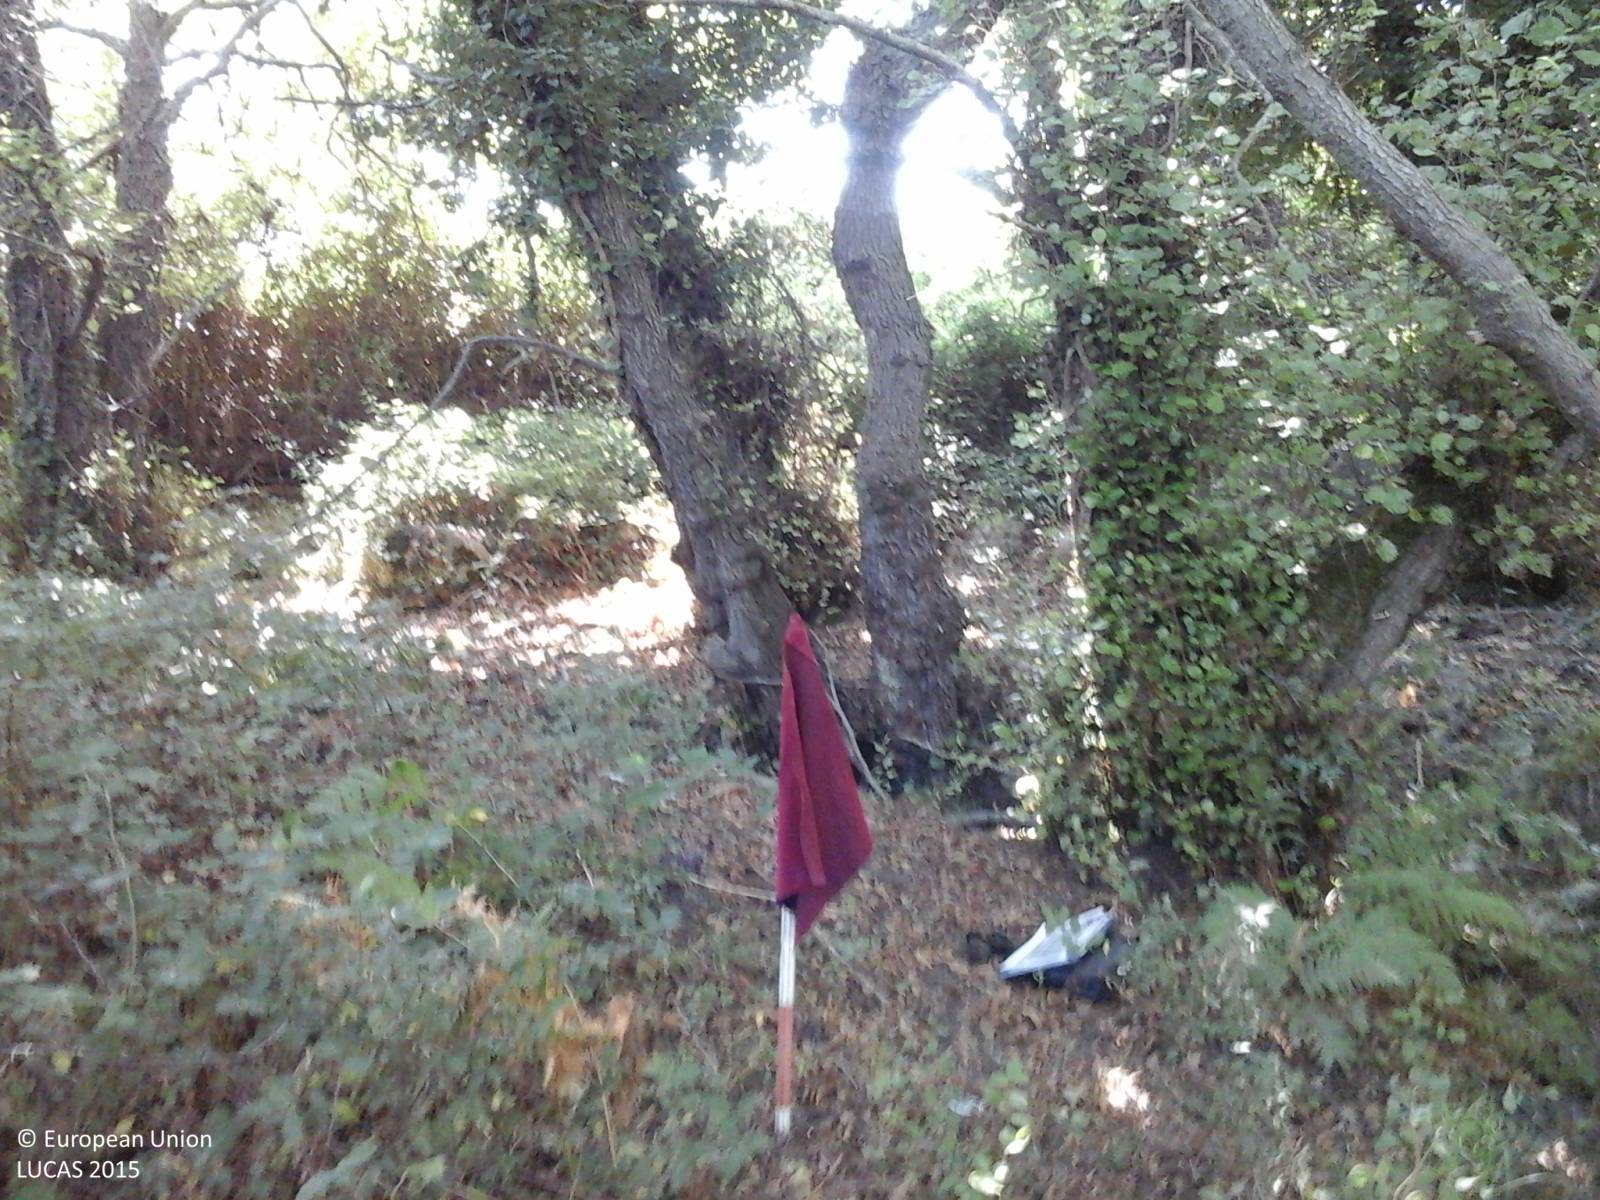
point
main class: Woodland
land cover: Broadleaved woodland
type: acidophilous oak and oak-birch forest
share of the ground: 10 - 25 %
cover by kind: unconsolidated bare surface 50 %, herbaceous plants 25 %, shrubs 15 %, broadleaved forest trees 10 %
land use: Semi-natural and natural areas not in use
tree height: > 5 m
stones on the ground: < 10 %
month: August
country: IT
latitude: 40.9876
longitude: 9.1600
